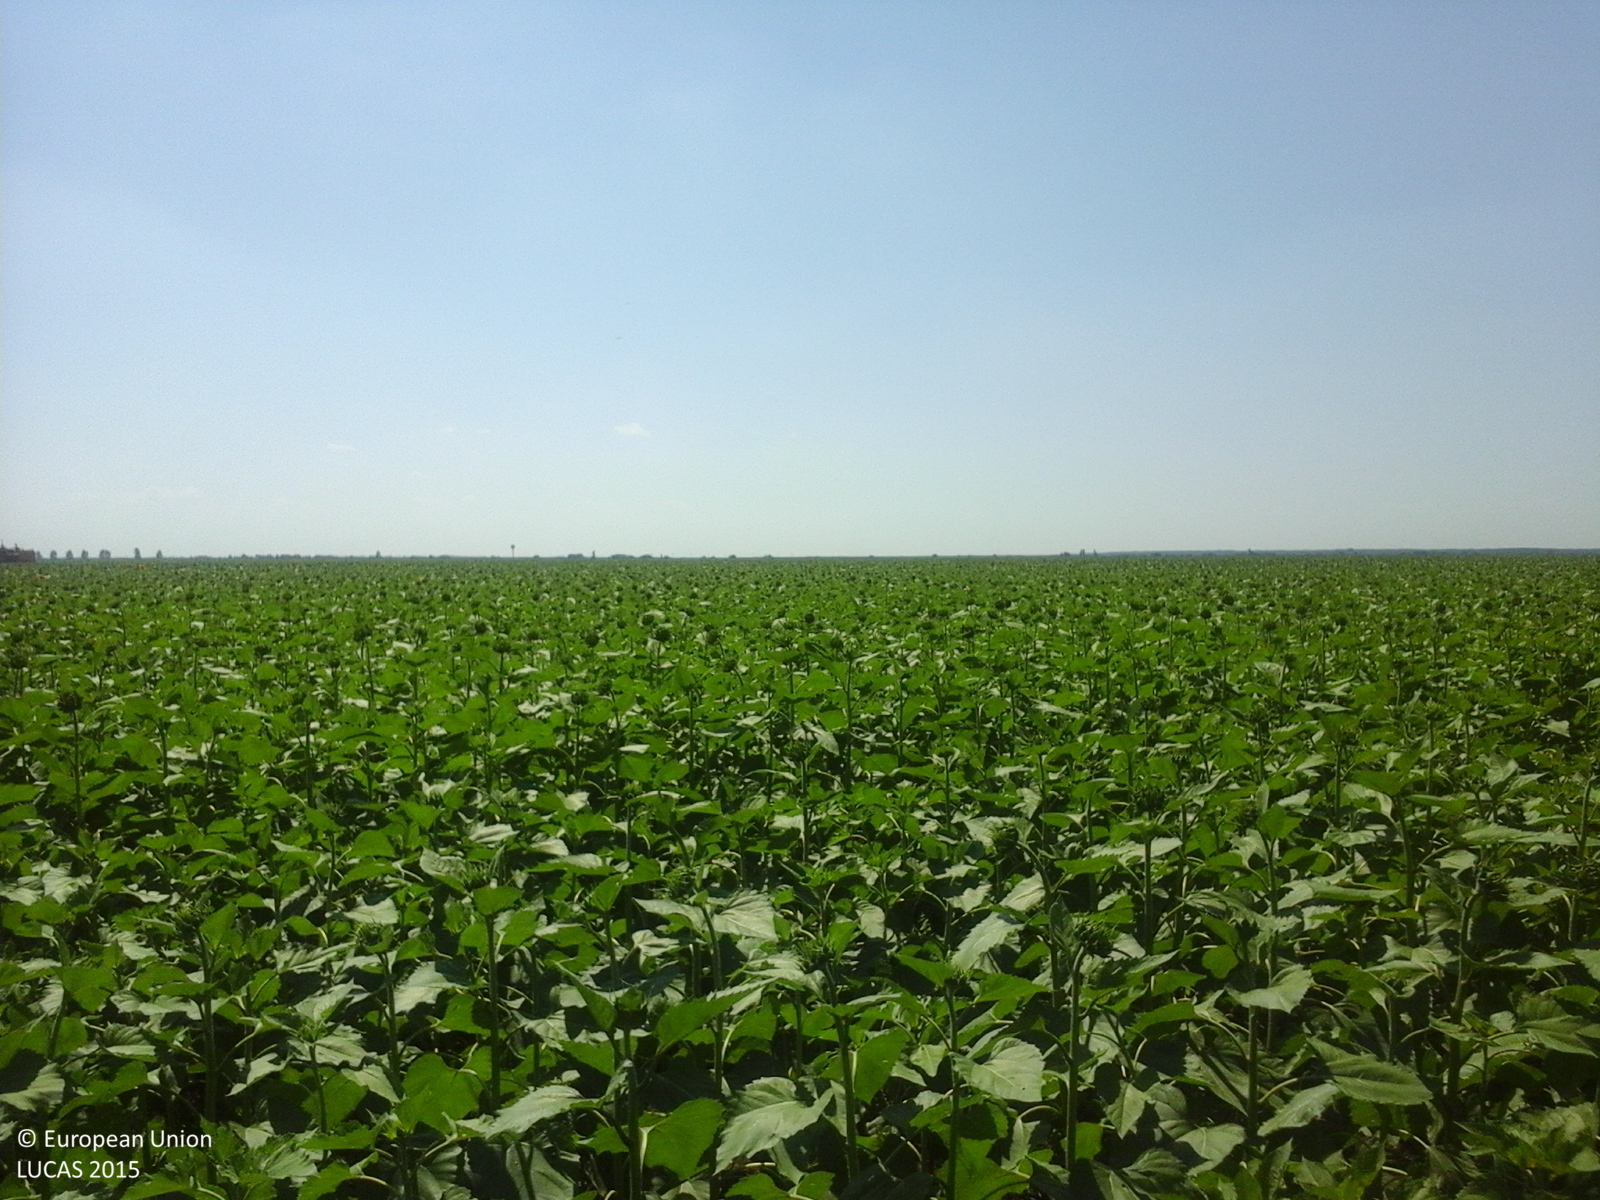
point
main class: Cropland
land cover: Sunflower
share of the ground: > 75 %
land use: Agriculture (excluding fallow land and kitchen gardens)
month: July
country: RO
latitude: 44.1414
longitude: 24.6845
